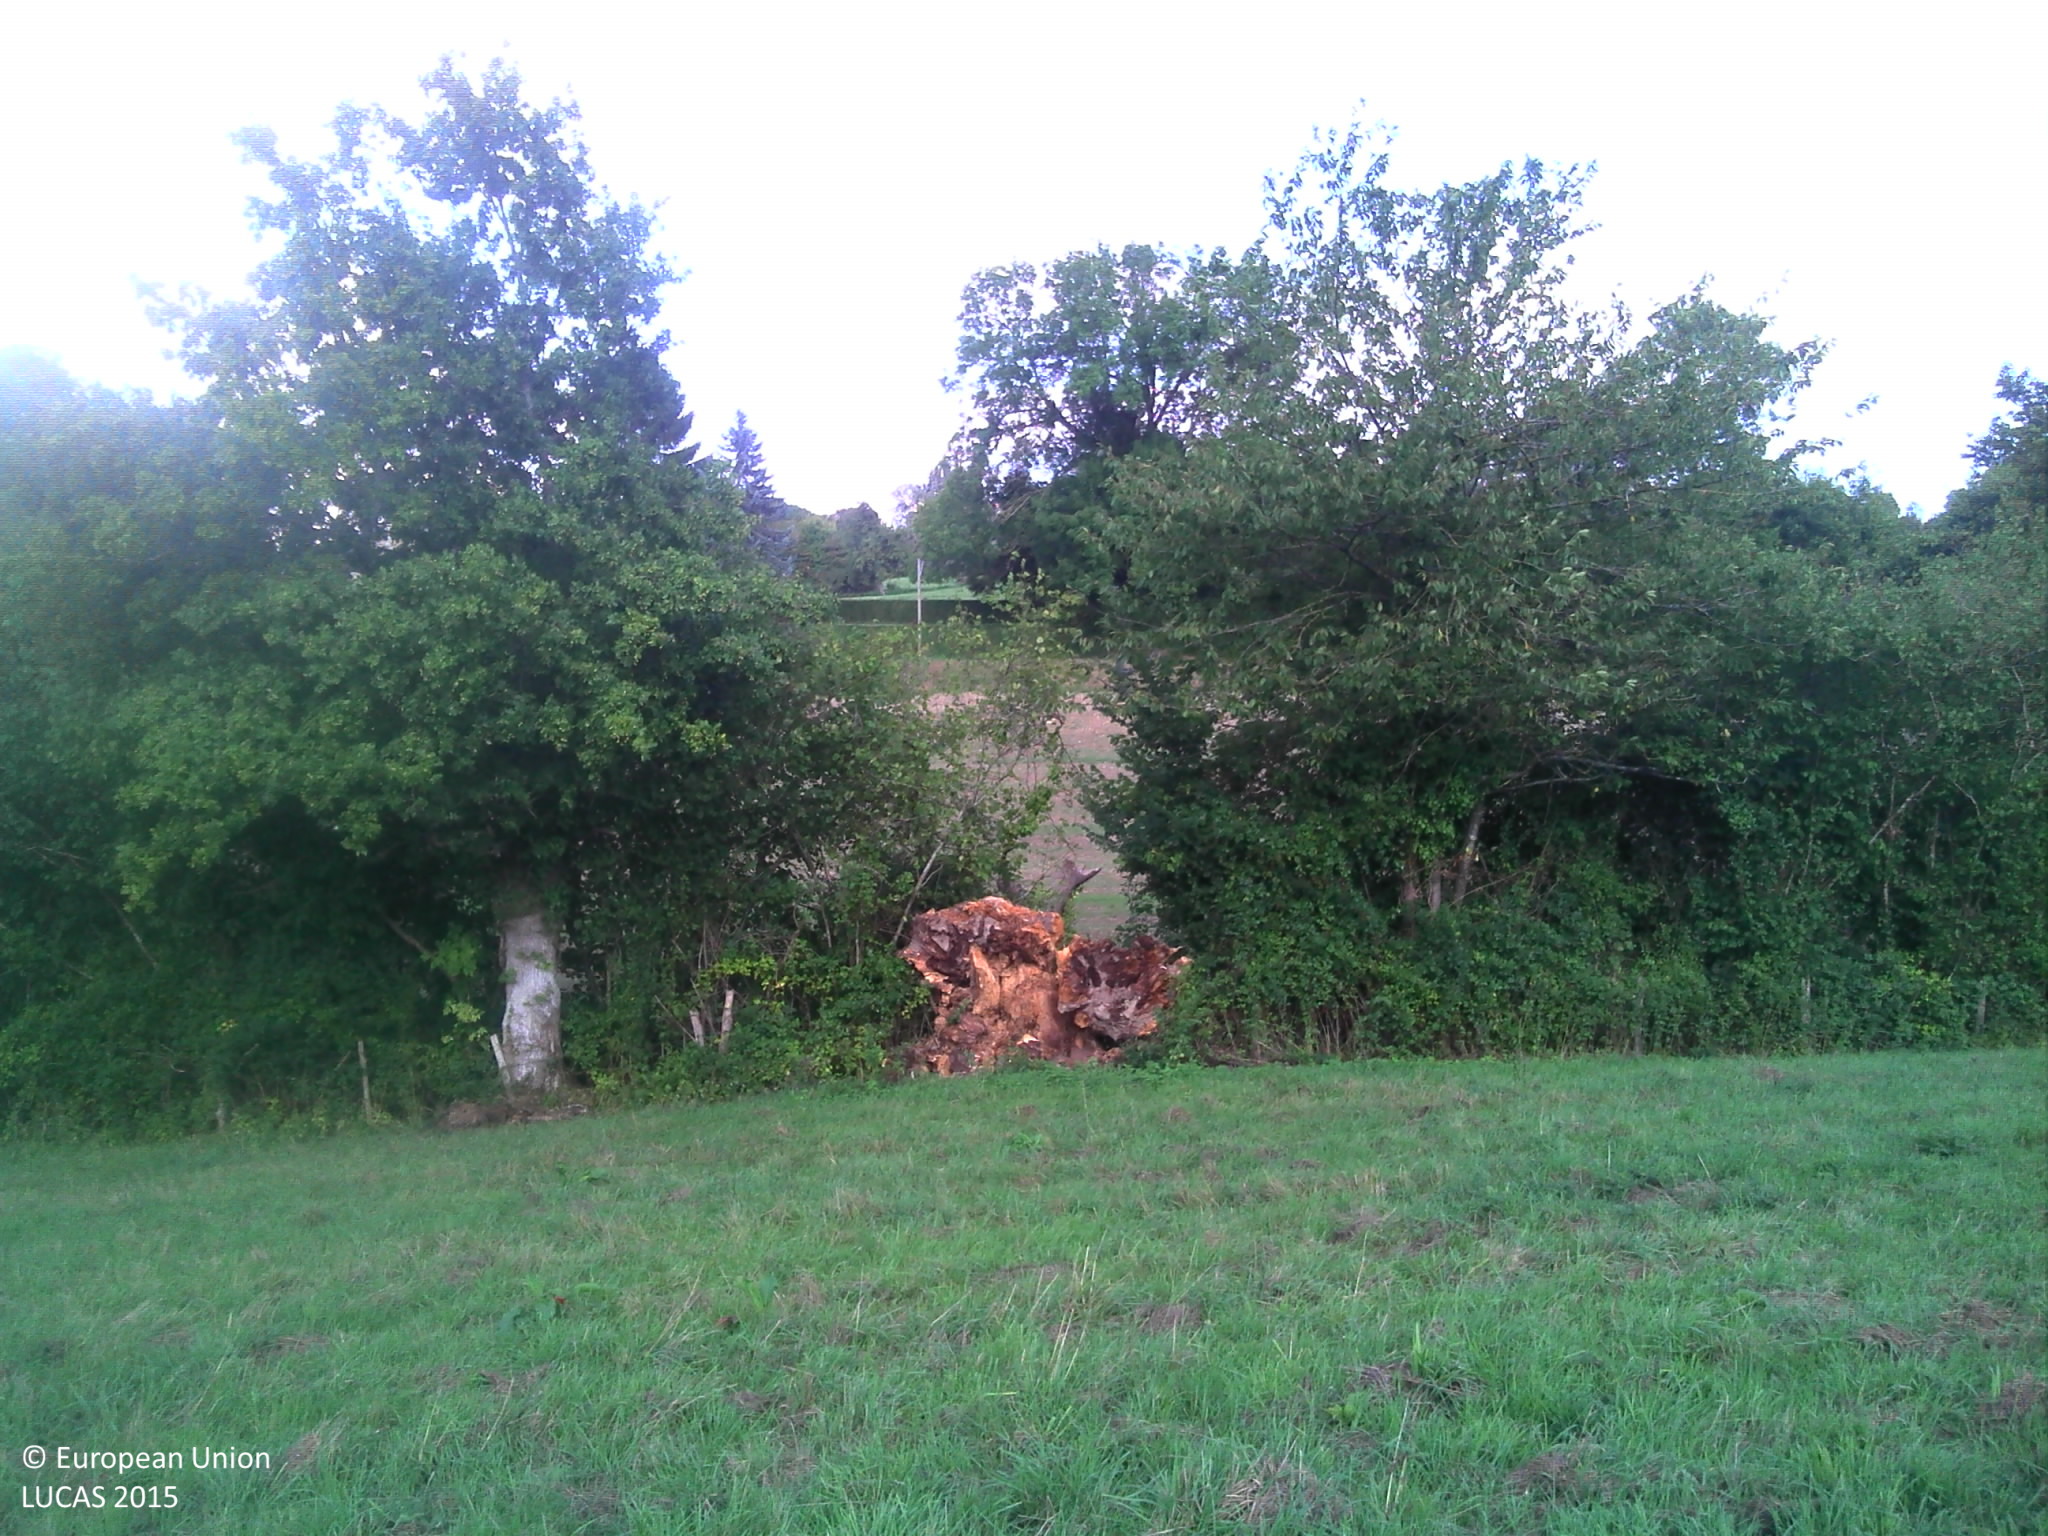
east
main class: Grassland
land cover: Grassland without tree/shrub cover
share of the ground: > 75 %
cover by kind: herbaceous plants 100 %
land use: Agriculture (excluding fallow land and kitchen gardens)
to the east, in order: Grassland without tree/shrub cover; Fences; Broadleaved woodland; Rivers and streams; Other bare soil; Grass margins; Electric lines; Paved roads, cycling and walking lanes; Broadleaved woodland; Grass margins; Fences; Grassland without tree/shrub cover; Groves; Grassland without tree/shrub cover
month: September
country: FR
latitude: 48.3797
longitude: 0.5653
